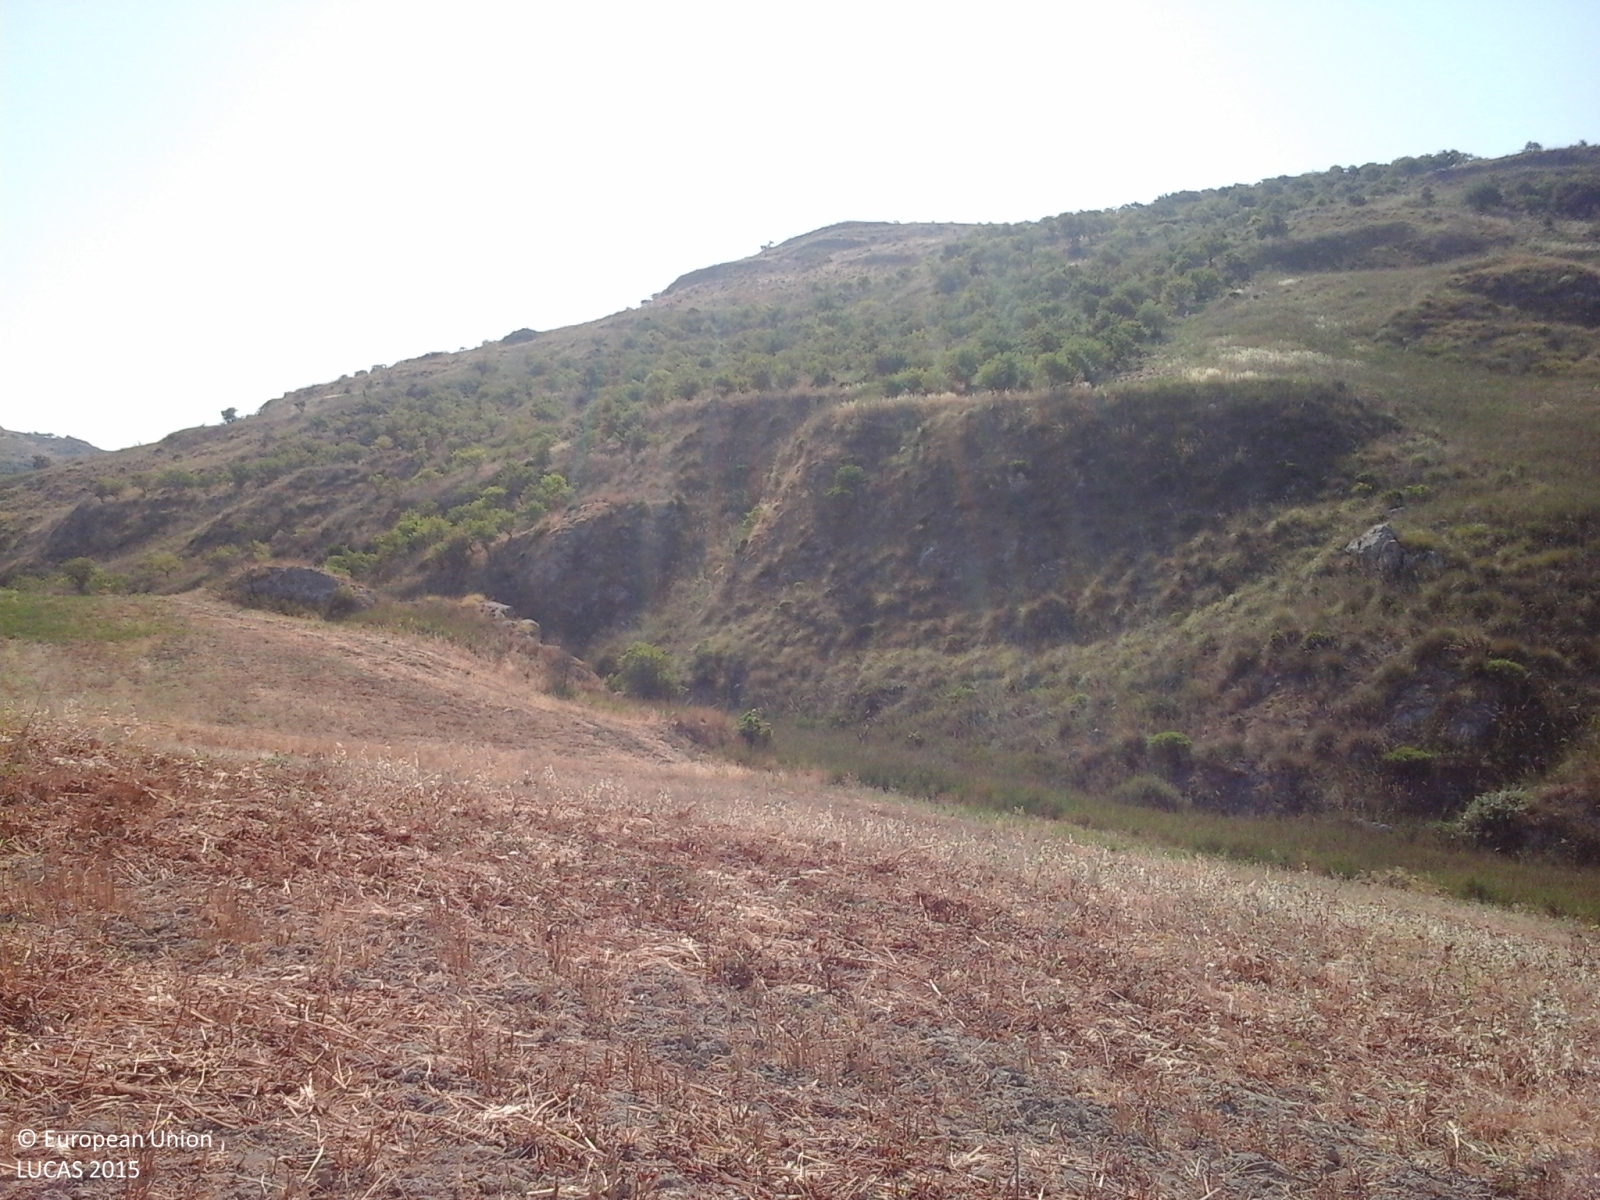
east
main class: Cropland
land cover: Lucerne
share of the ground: > 75 %
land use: Agriculture (excluding fallow land and kitchen gardens)
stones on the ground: < 10 %
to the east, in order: Lucerne; Rivers and streams; Grassland without tree/shrub cover; Nuts trees
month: July
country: IT
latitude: 37.4110
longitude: 13.4868
